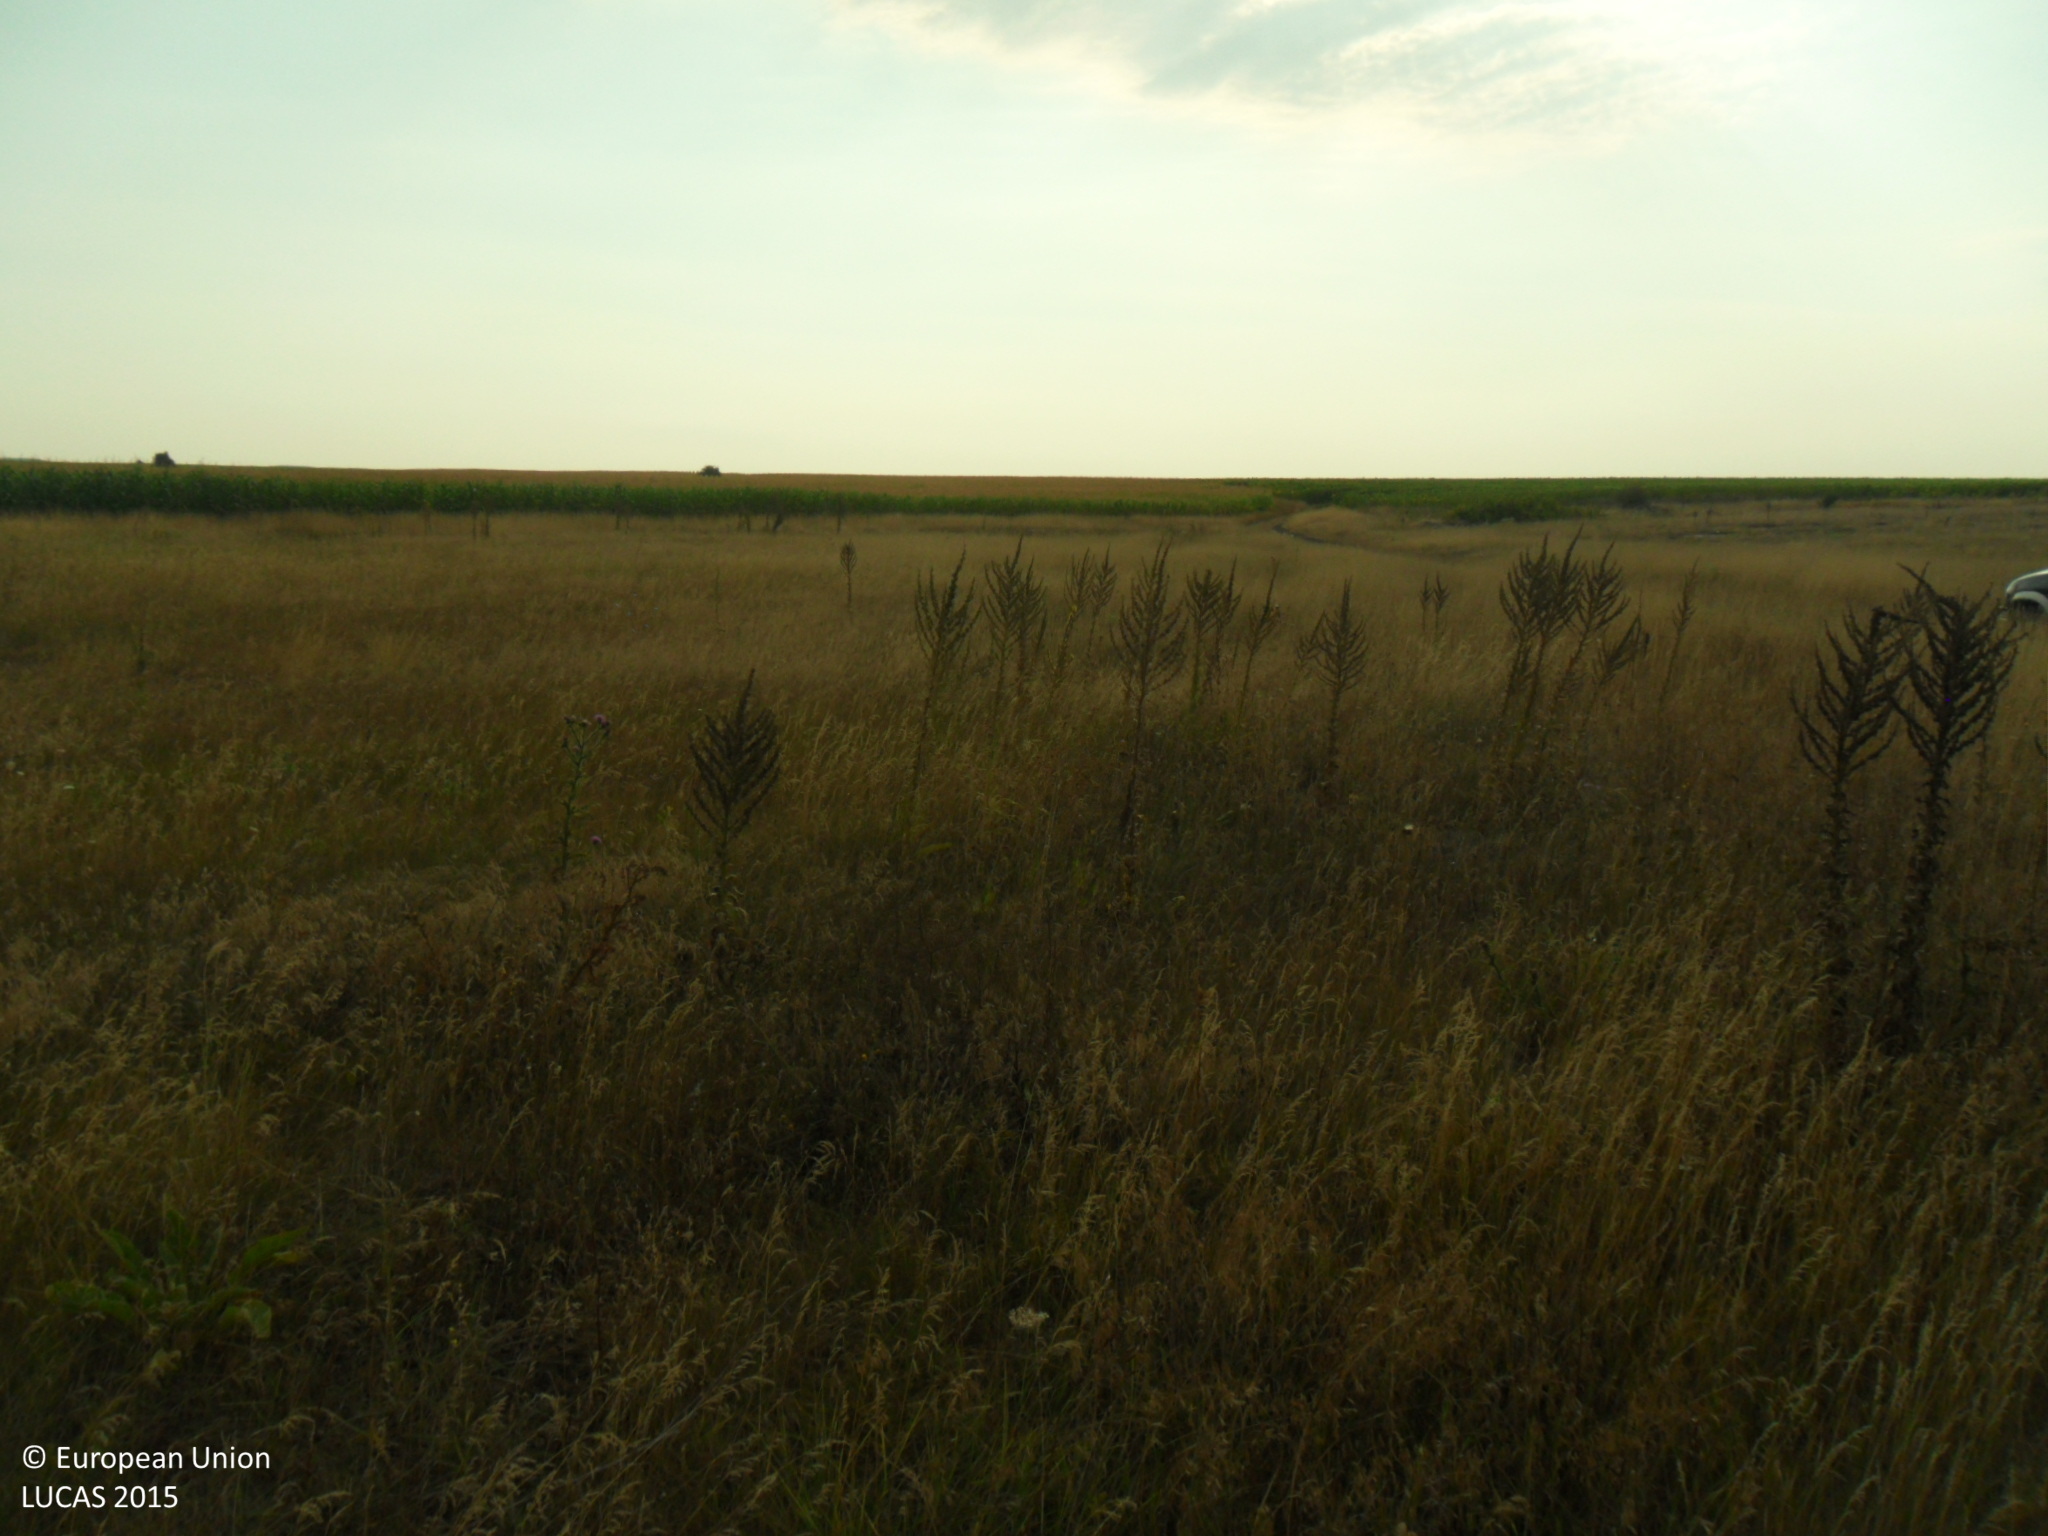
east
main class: Grassland
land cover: Spontaneously vegetated surfaces
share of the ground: > 75 %
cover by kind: herbaceous plants 100 %
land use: Fallow land
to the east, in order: Spontaneously vegetated surfaces; Tracks; Spontaneously vegetated surfaces; Sunflower
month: July
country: BG
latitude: 43.4180
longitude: 26.9745
